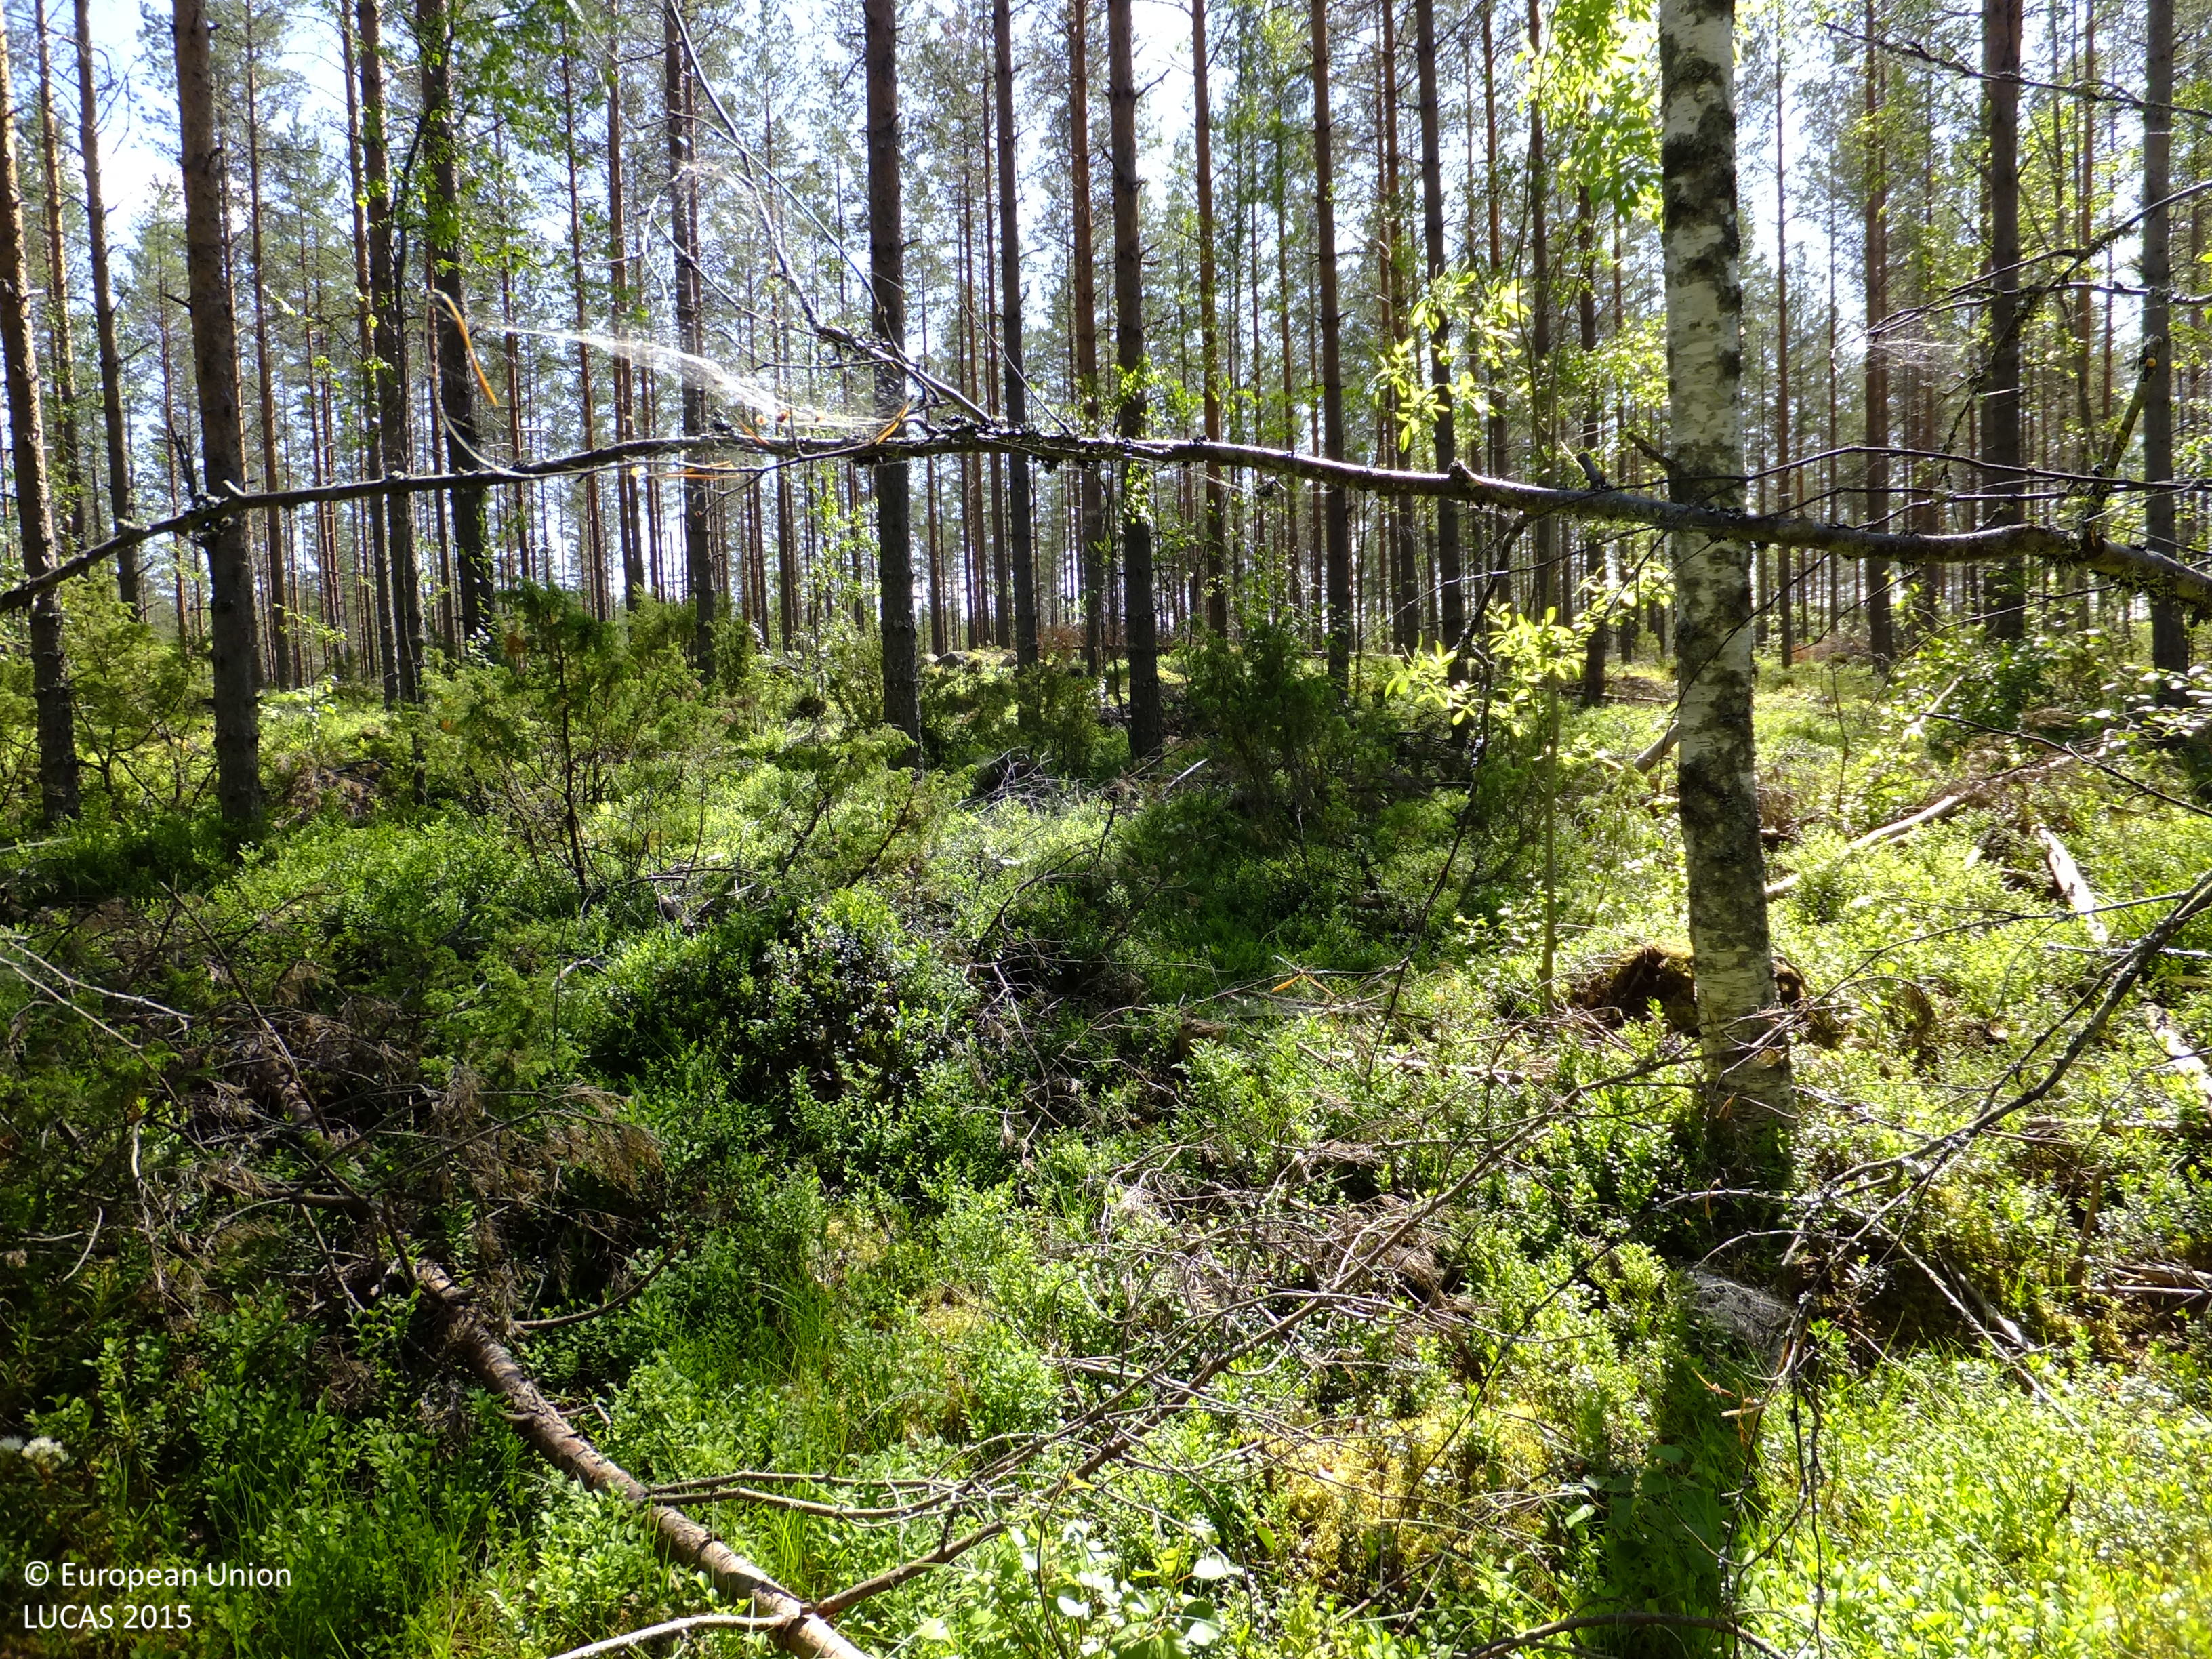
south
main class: Woodland
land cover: Pine dominated mixed woodland
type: boreal forest
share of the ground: 50 - 75 %
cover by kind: coniferous forest trees 40 %, shrubs 30 %, broadleaved forest trees 20 %, herbaceous plants 5 %, lichens and mosses 5 %
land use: Forestry
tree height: > 5 m
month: July
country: FI
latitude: 63.2242
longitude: 24.7514
